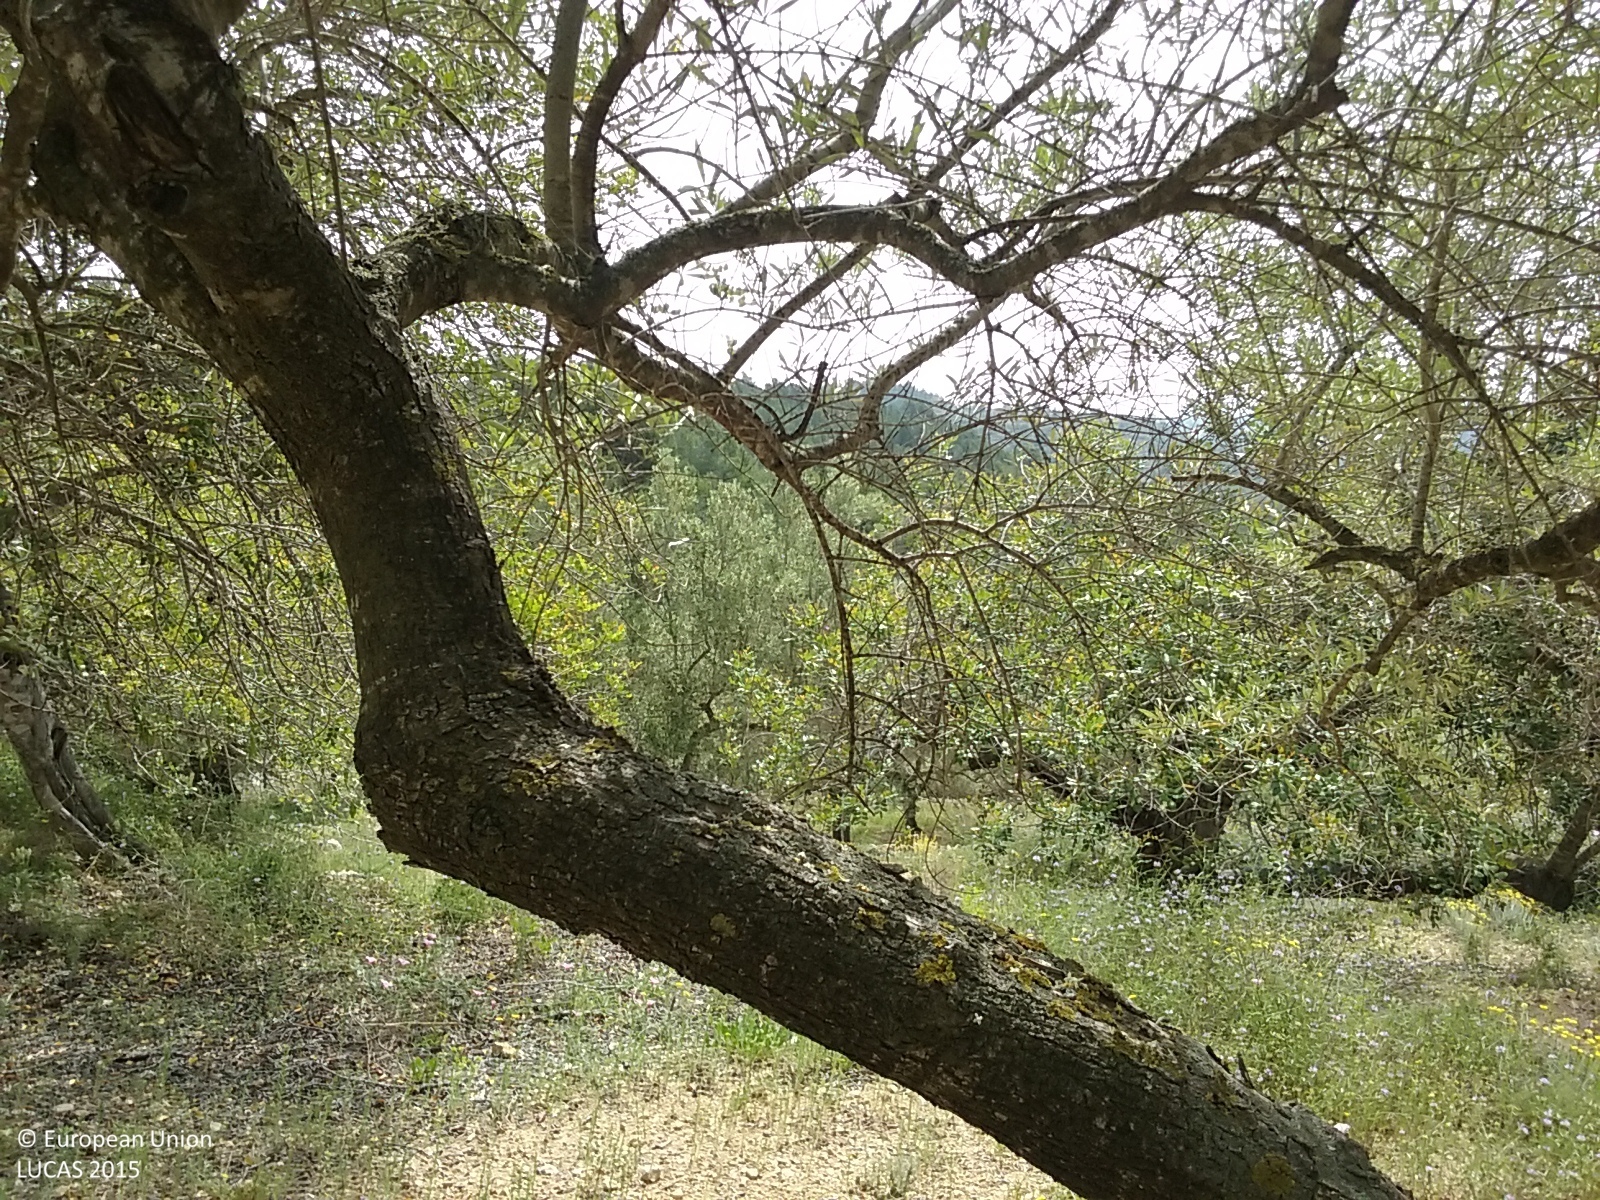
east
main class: Cropland
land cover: Olive groves
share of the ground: 50 - 75 %
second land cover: Spontaneously vegetated surfaces
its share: 50 - 75 %
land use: Agriculture (excluding fallow land and kitchen gardens)
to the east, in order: Dry stone walls; Olive groves; Dry stone walls; Olive groves; Dry stone walls; Olive groves; Dry stone walls; Olive groves; Dry stone walls; Olive groves; Dry stone walls; Paved roads, cycling and walking lanes; Pine dominated coniferous woodland; Dry stone walls; Pine dominated coniferous woodland; Dry stone walls; Pine dominated coniferous woodland; Dry stone walls; Pine dominated coniferous woodland; Dry stone walls; Pine dominated coniferous woodland; Dry stone walls; Pine dominated coniferous woodland; Dry stone walls; Pine dominated coniferous woodland; Dry stone walls; Pine dominated coniferous woodland; Dry stone walls; Pine dominated coniferous woodland; Dry stone walls; Shrubland with sparse tree cover; Pine dominated coniferous woodland
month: May
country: ES
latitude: 40.7772
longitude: 0.5746
